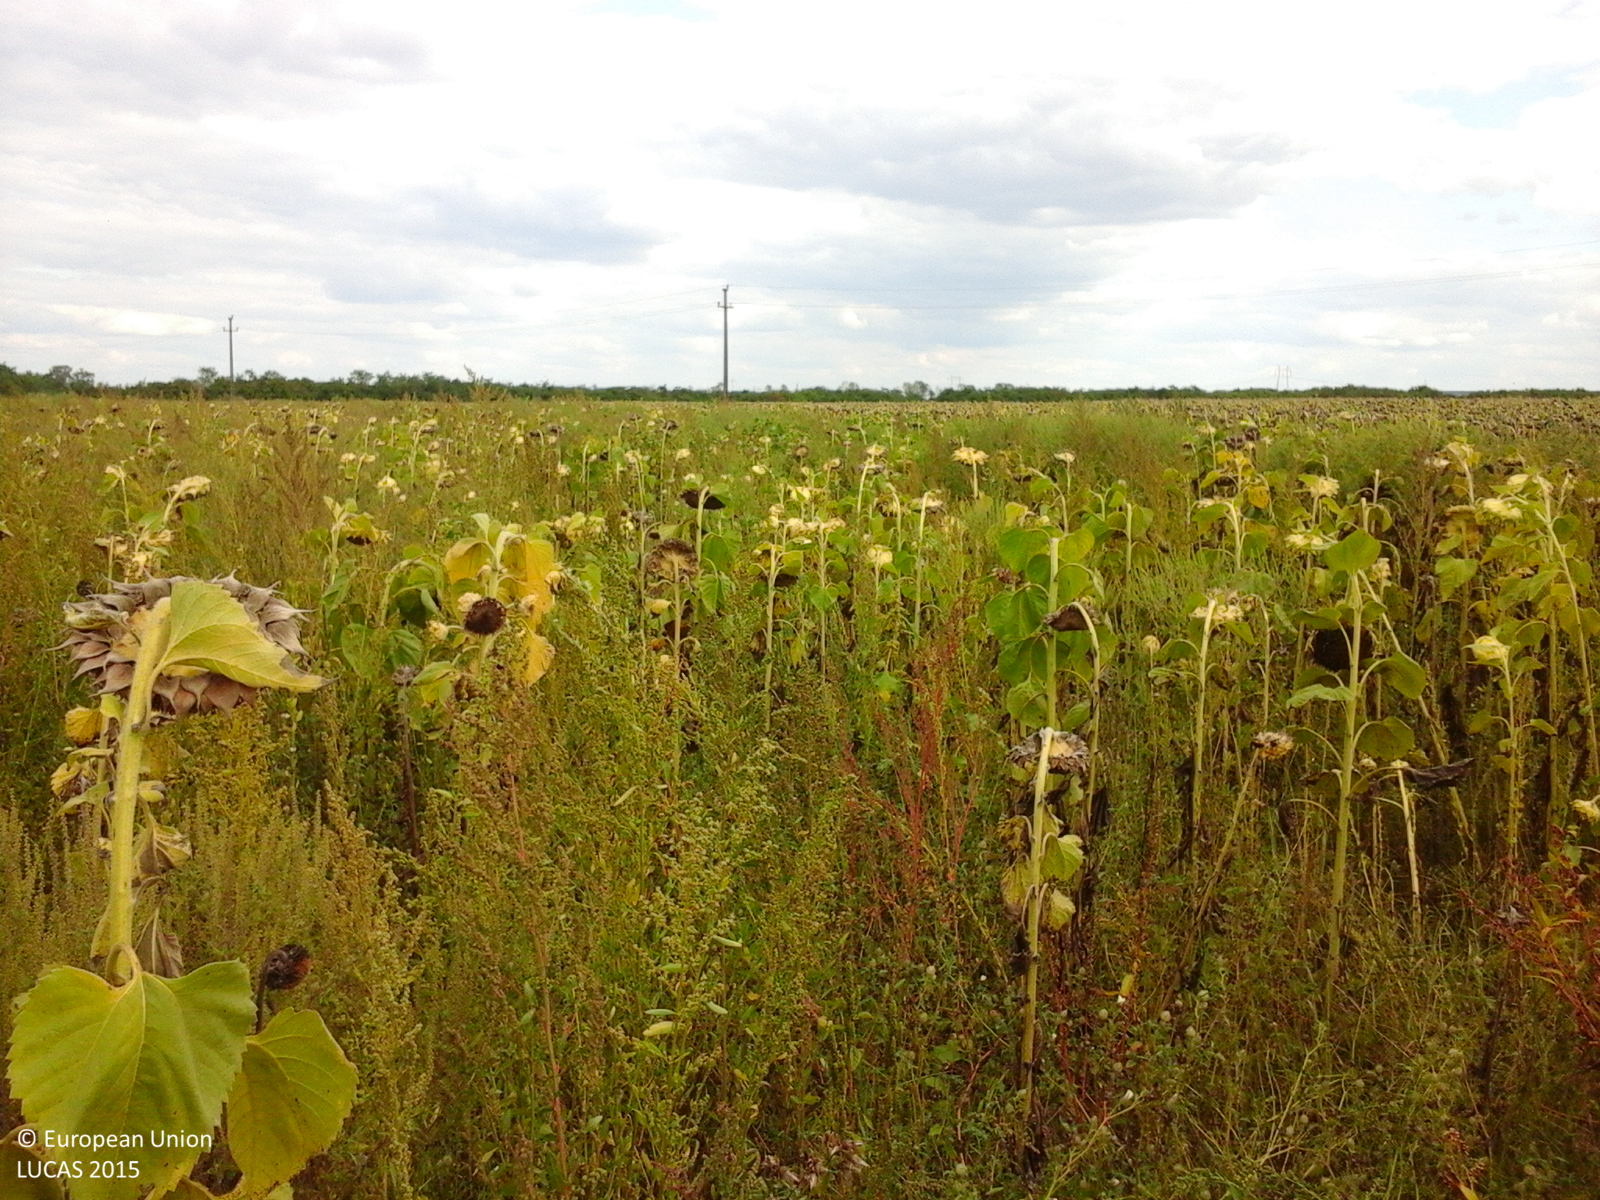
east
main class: Cropland
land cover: Sunflower
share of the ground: 50 - 75 %
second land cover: Spontaneously vegetated surfaces
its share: 25 - 50 %
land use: Agriculture (excluding fallow land and kitchen gardens)
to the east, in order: Sunflower; Spontaneously vegetated surfaces; Electric lines; Sunflower; Grass margins; Tracks; Grass margins; Shrubland with sparse tree cover; Sunflower
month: September
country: RO
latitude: 47.5145
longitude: 22.6073
